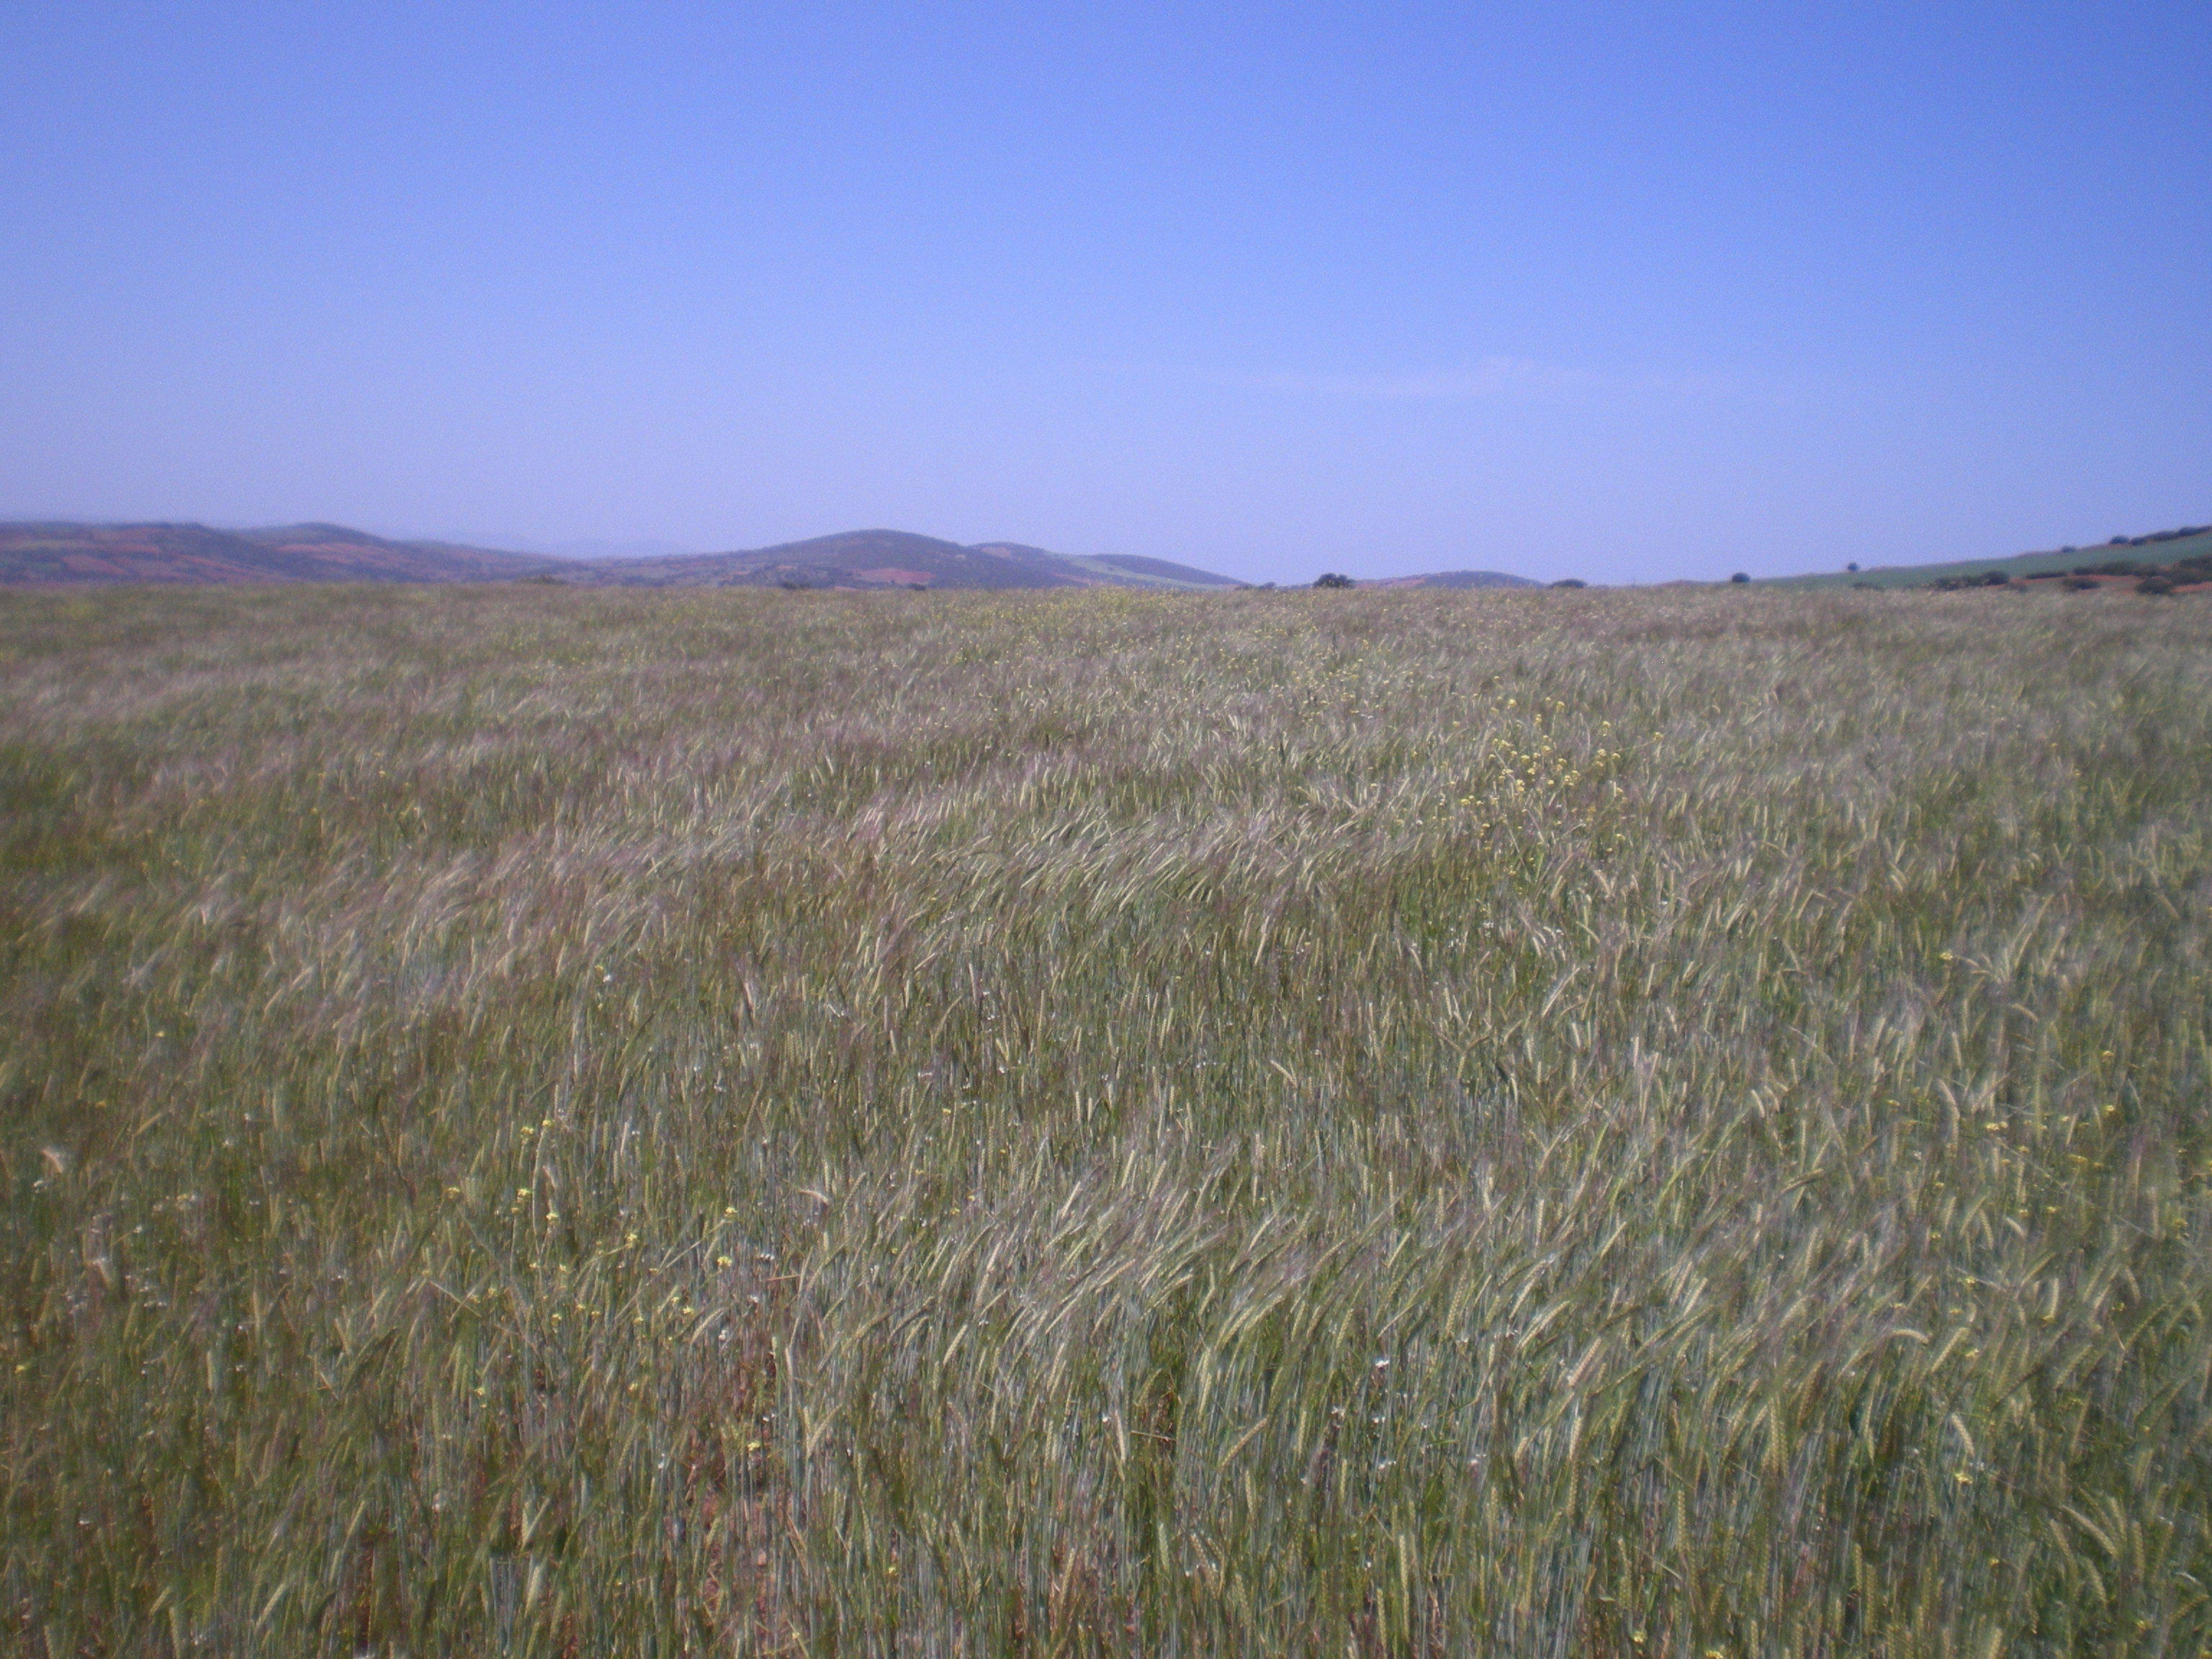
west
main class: Cropland
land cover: Barley
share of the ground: > 75 %
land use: Agriculture (excluding fallow land and kitchen gardens)
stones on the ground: 10 - 25 %
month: April
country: ES
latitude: 38.5575
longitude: -3.5162
